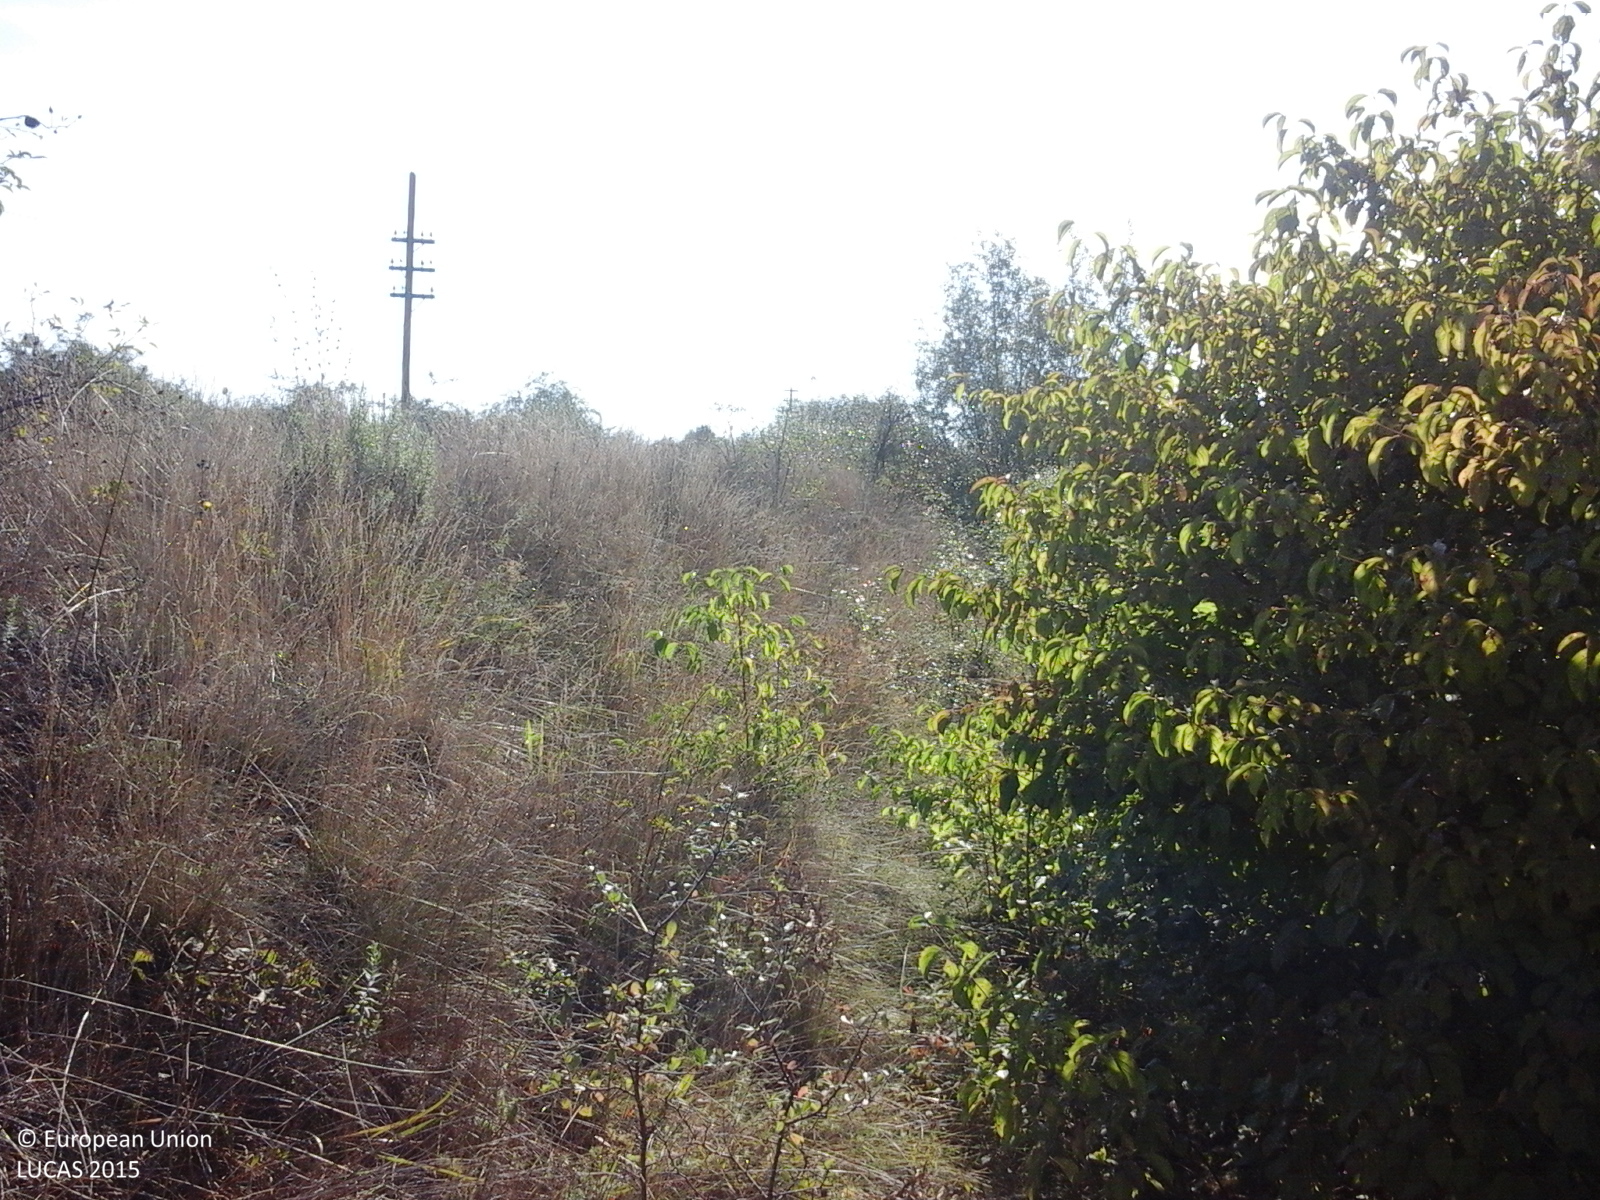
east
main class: Grassland
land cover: Spontaneously vegetated surfaces
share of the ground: > 75 %
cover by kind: herbaceous plants 100 %
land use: Semi-natural and natural areas not in use
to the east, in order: Ditches and canals; Spontaneously vegetated surfaces; Shrubland without tree cover; Electric lines; Railways; Shrubland without tree cover; Grass margins; Tracks; Grass margins; Fences; Grassland without tree/shrub cover; Fences; Grassland without tree/shrub cover; Tracks; Spontaneously vegetated surfaces
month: August
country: RO
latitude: 45.6965
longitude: 21.2938
